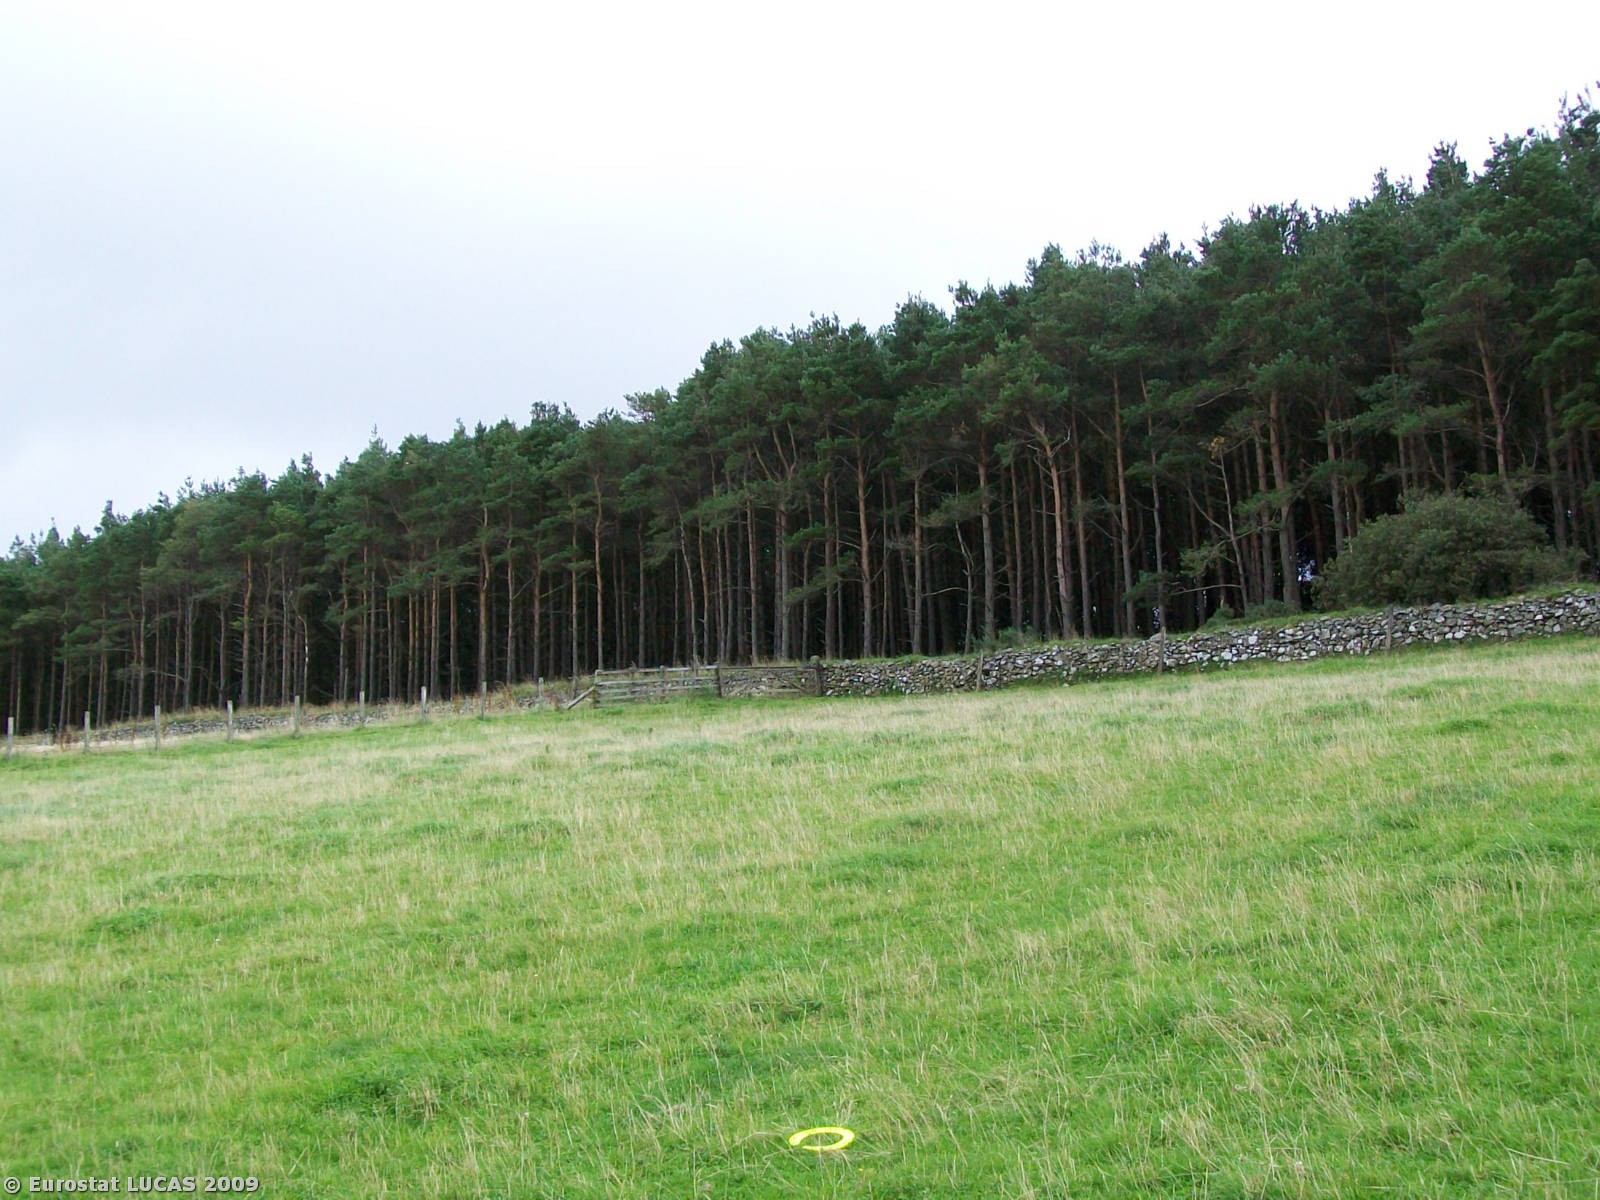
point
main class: Grassland
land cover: Grassland without tree/shrub cover
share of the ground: > 75 %
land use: Agriculture (excluding fallow land and kitchen gardens)
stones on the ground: < 10 %
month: September
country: GB
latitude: 55.8268
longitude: -2.3329
